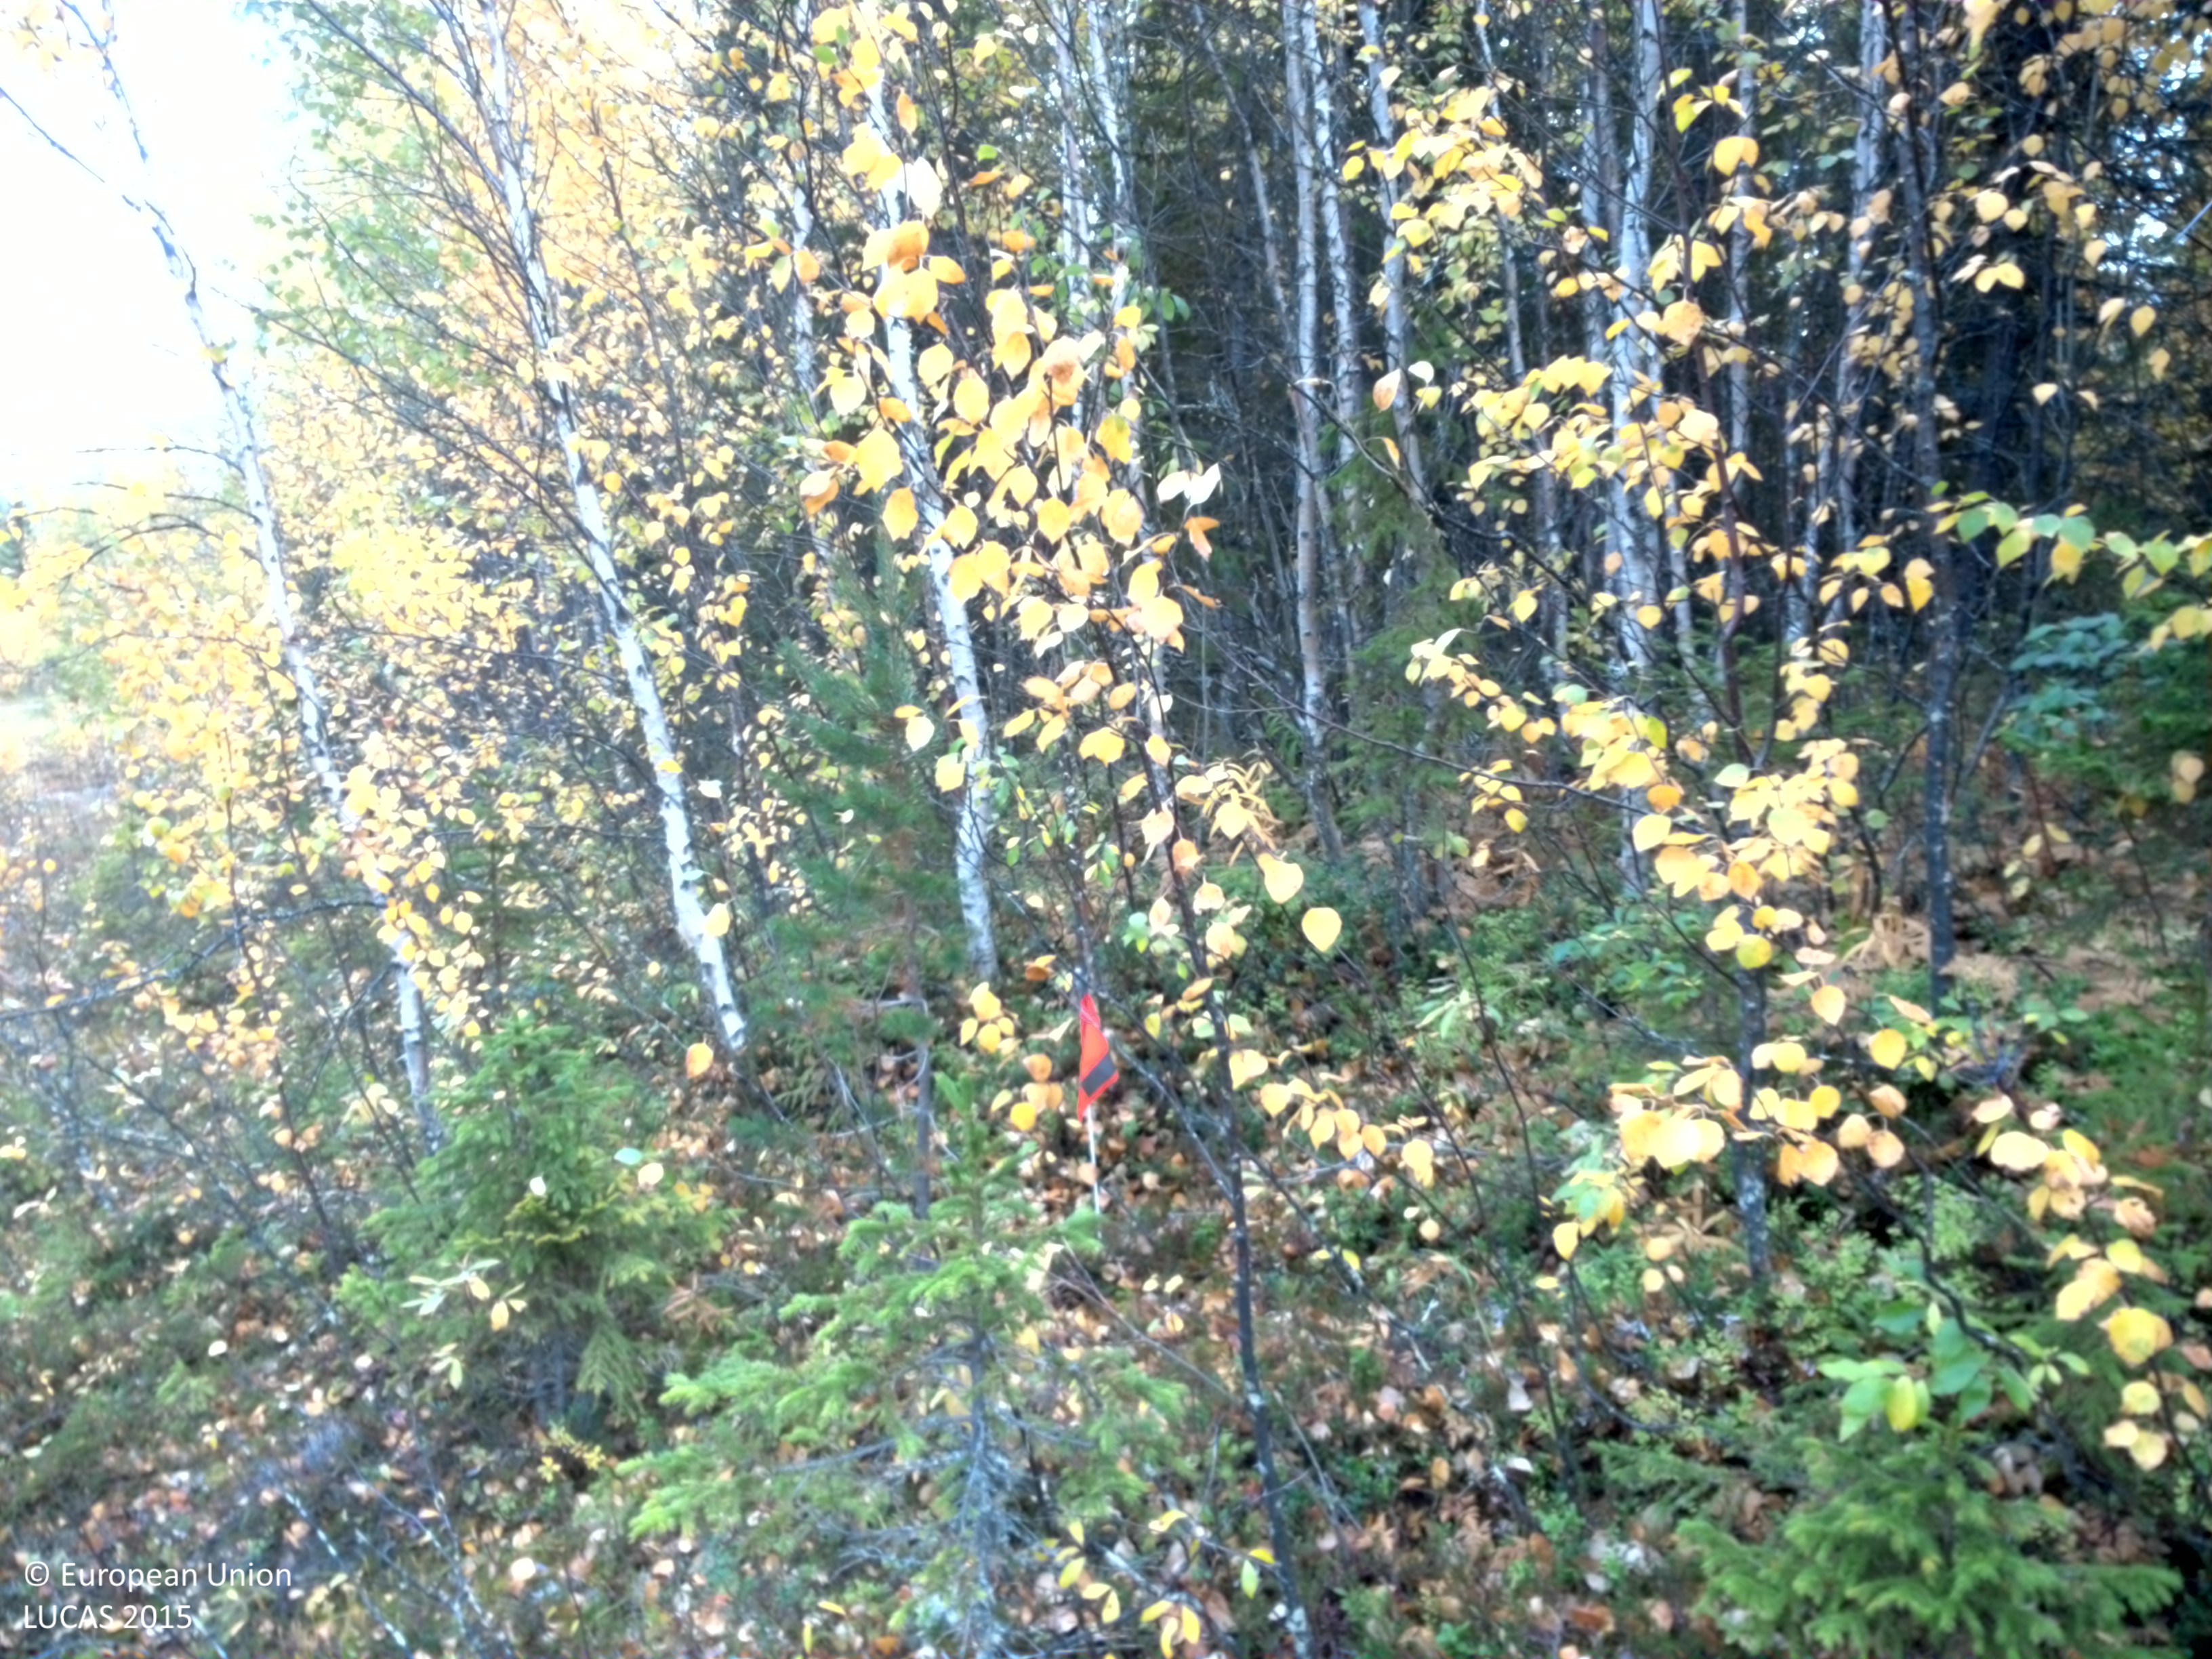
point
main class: Woodland
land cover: Broadleaved woodland
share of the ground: 50 - 75 %
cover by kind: broadleaved forest trees 50 %, shrubs 25 %, herbaceous plants 10 %, lichens and mosses 10 %, coniferous forest trees 5 %
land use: Forestry
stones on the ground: < 10 %
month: September
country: SE
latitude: 65.3606
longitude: 16.3044
